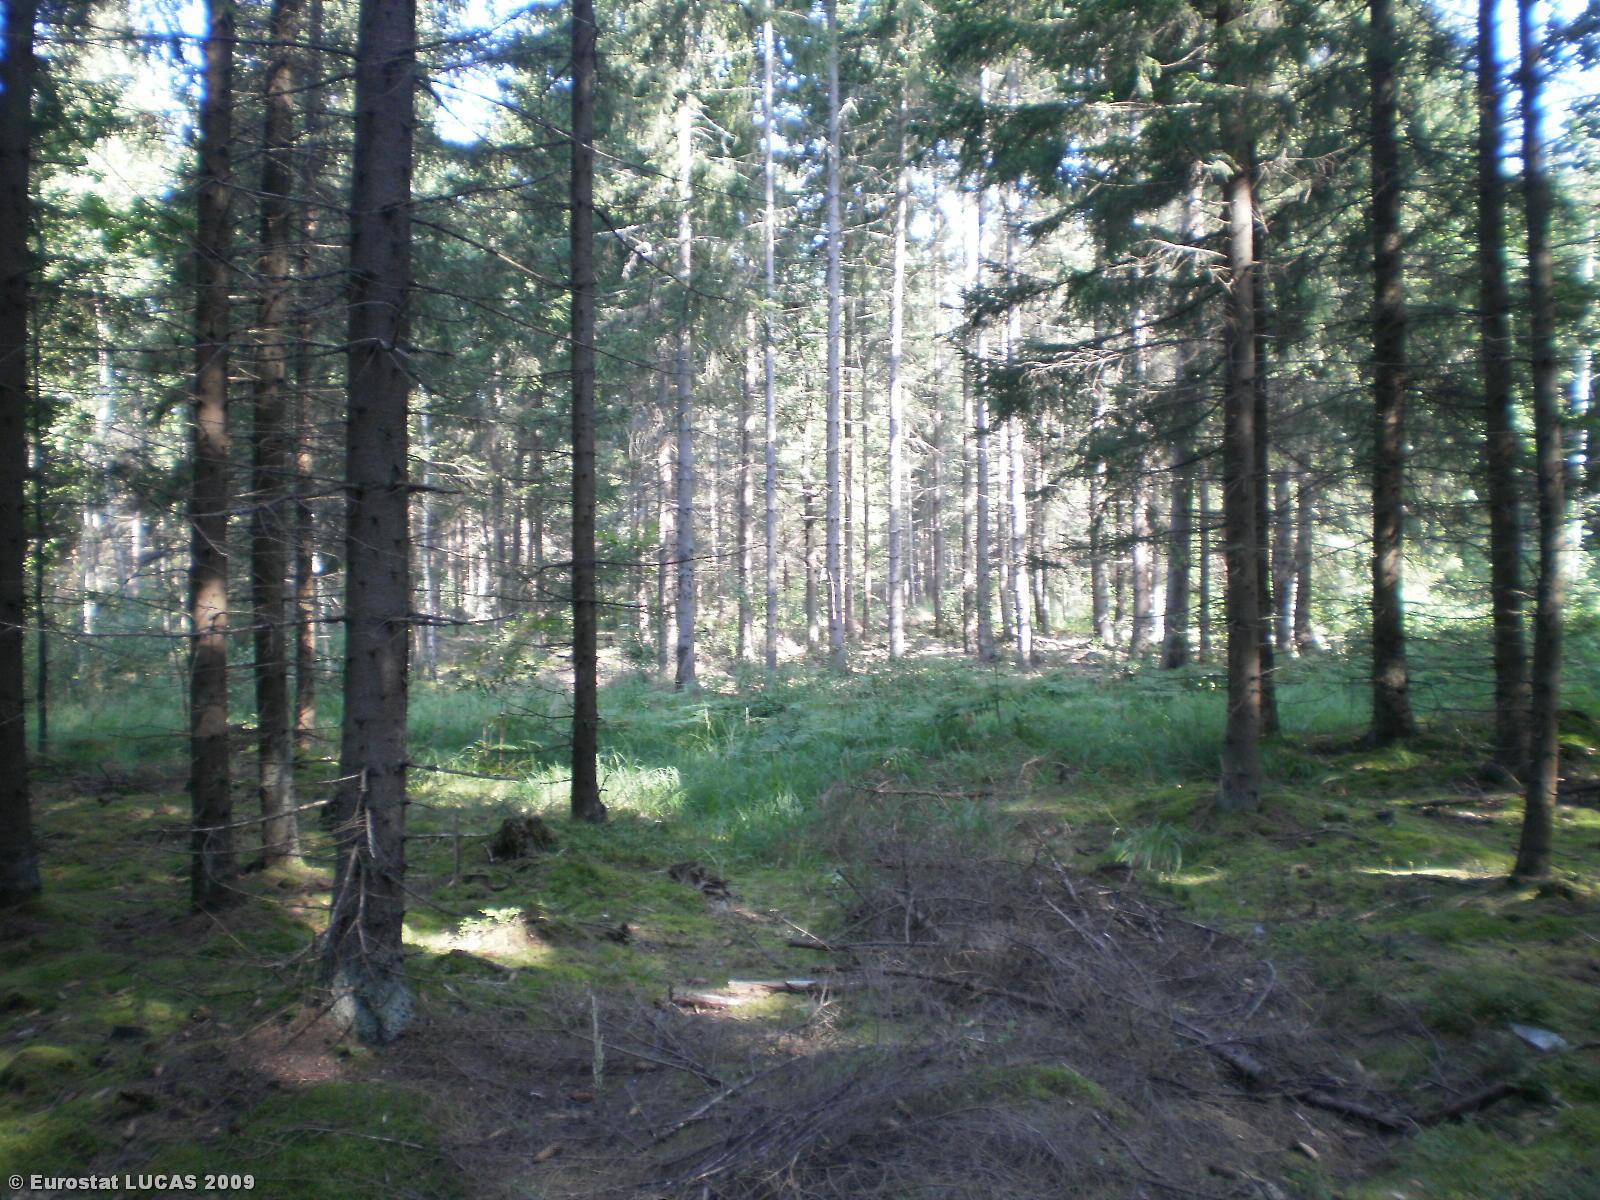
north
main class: Woodland
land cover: Coniferous woodland
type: hemiboreal forest and nemoral coniferous forest and mixed broadleaved-coniferous forest
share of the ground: > 75 %
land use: Forestry
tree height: > 5 m
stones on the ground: < 10 %
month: August
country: LT
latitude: 55.5667
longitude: 24.9044
